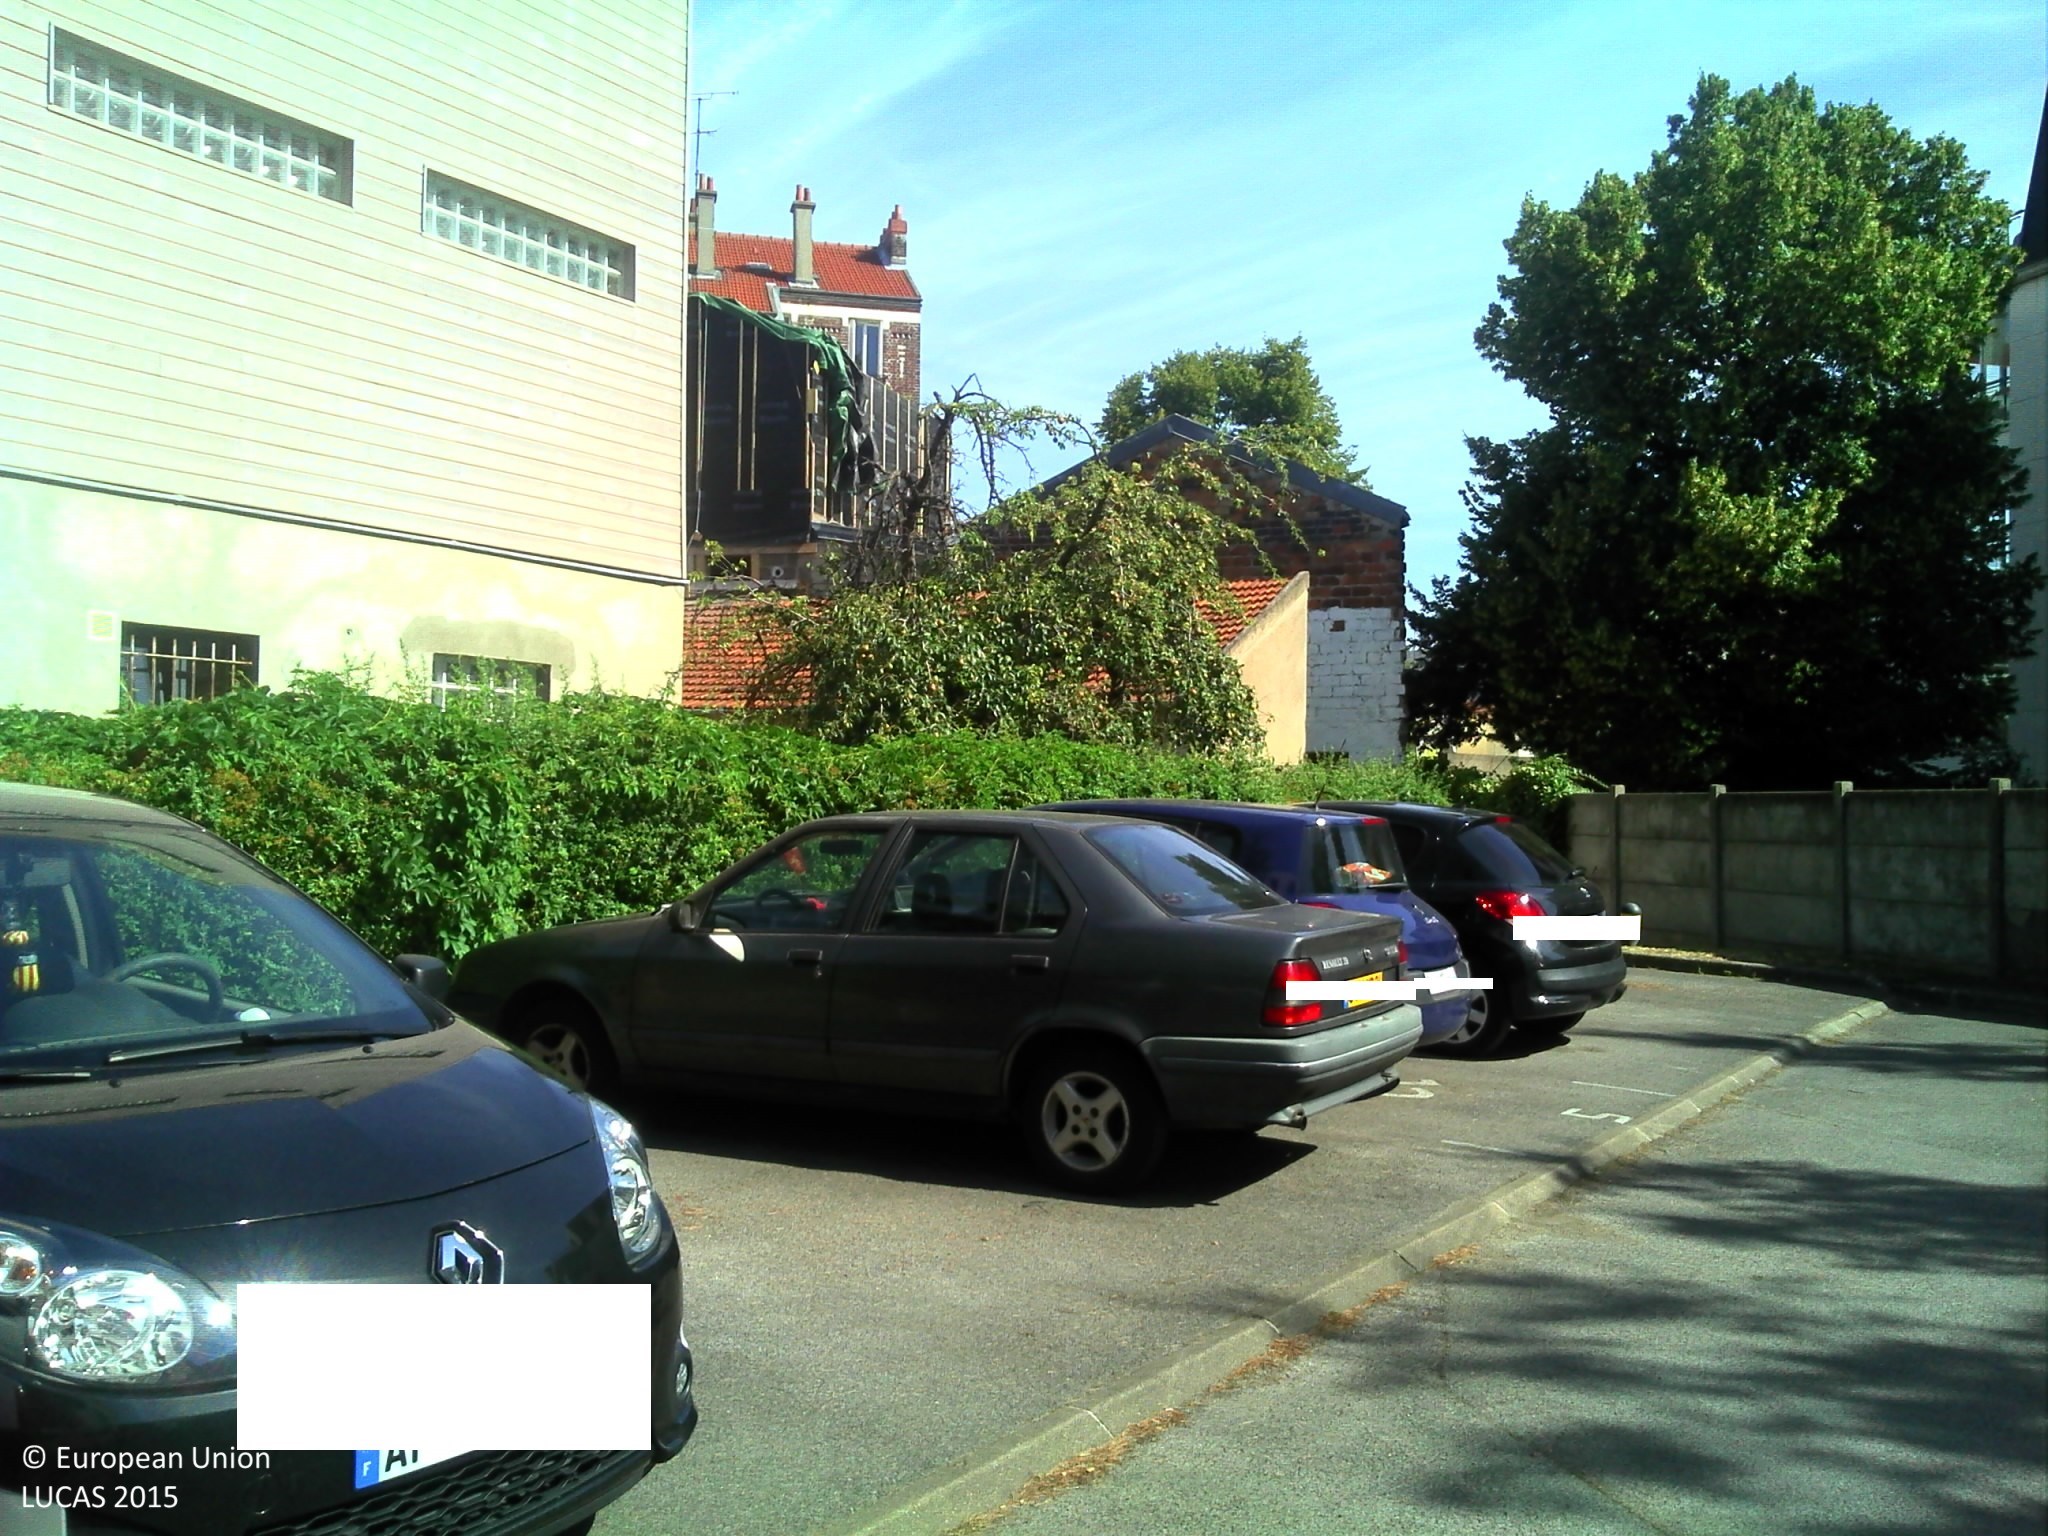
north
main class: Grassland
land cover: Grassland with sparse tree/shrub cover
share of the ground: > 75 %
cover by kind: herbaceous plants 95 %, broadleaved forest trees 5 %
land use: Road transport
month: August
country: FR
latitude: 48.8124
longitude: 2.4306
